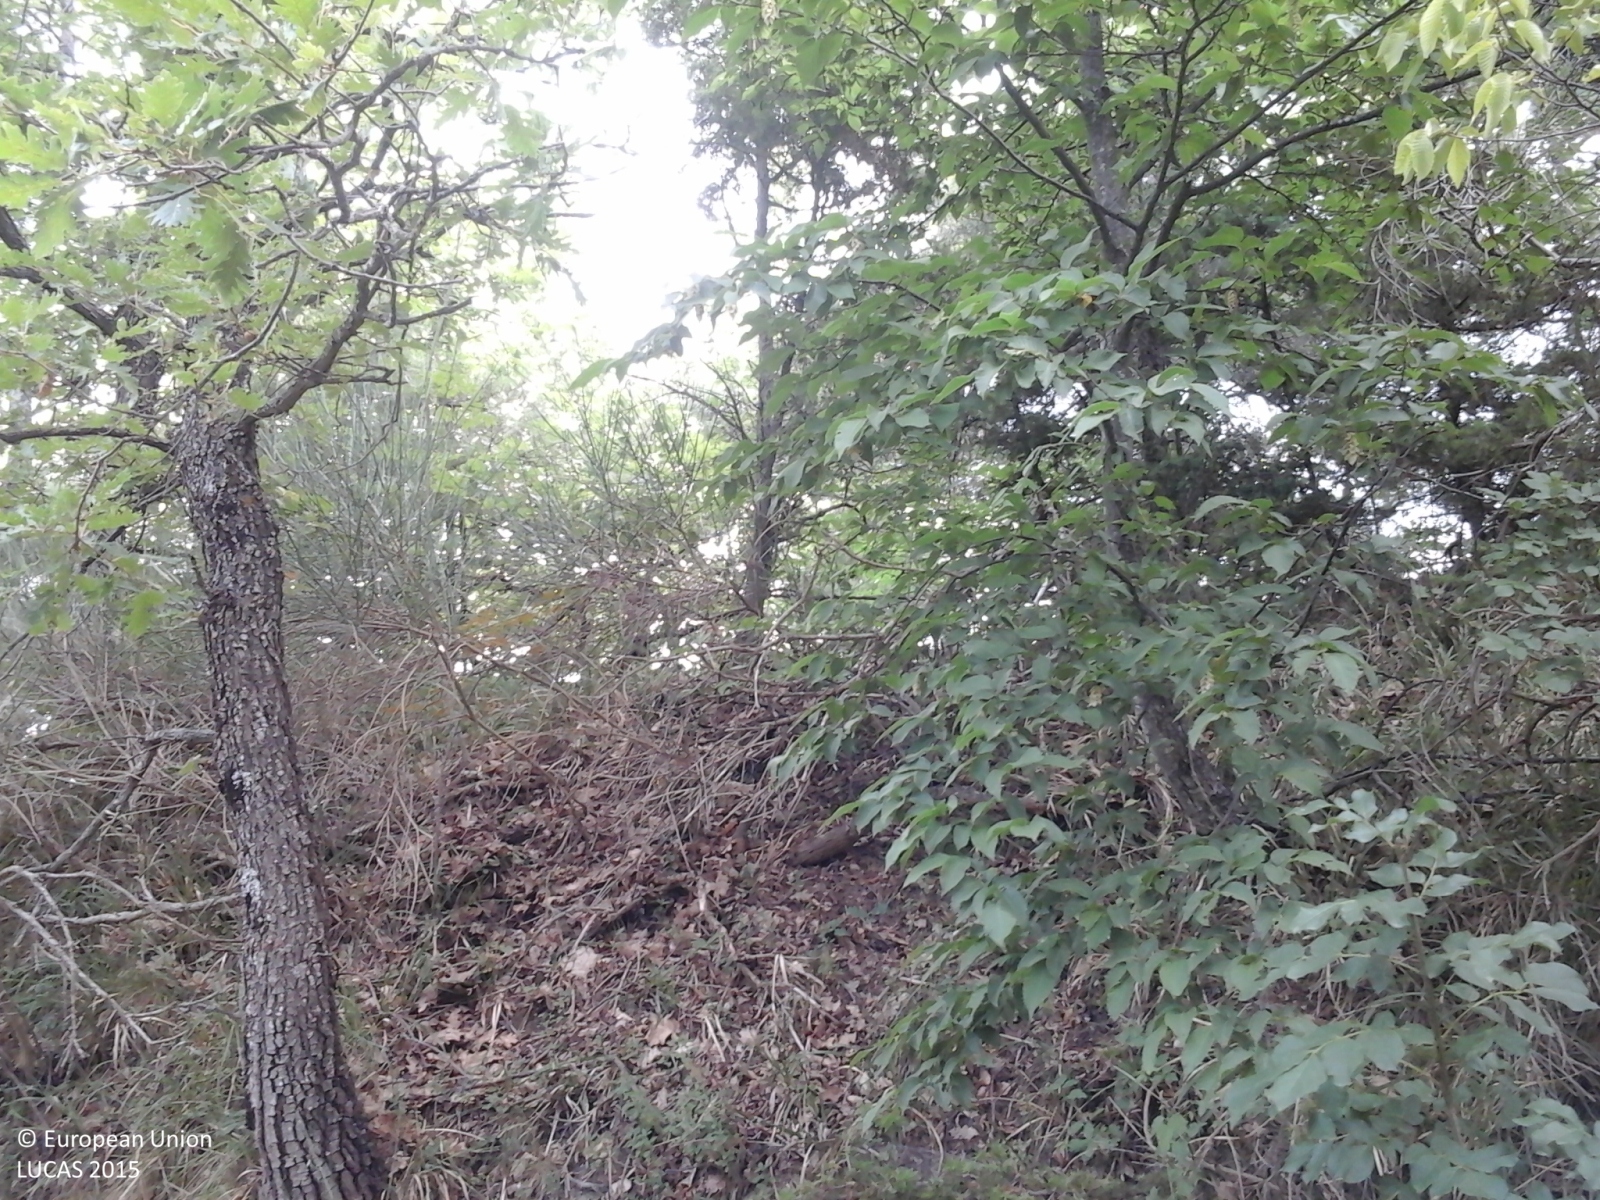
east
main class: Woodland
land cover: Broadleaved woodland
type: mesophytic deciduous forest
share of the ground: > 75 %
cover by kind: broadleaved forest trees 100 %
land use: Forestry
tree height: > 5 m
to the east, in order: Broadleaved woodland; Tracks; Broadleaved woodland; Tracks; Broadleaved woodland; Tracks; Broadleaved woodland; Grassland with sparse tree/shrub cover
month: July
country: IT
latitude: 44.7797
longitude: 9.1298
